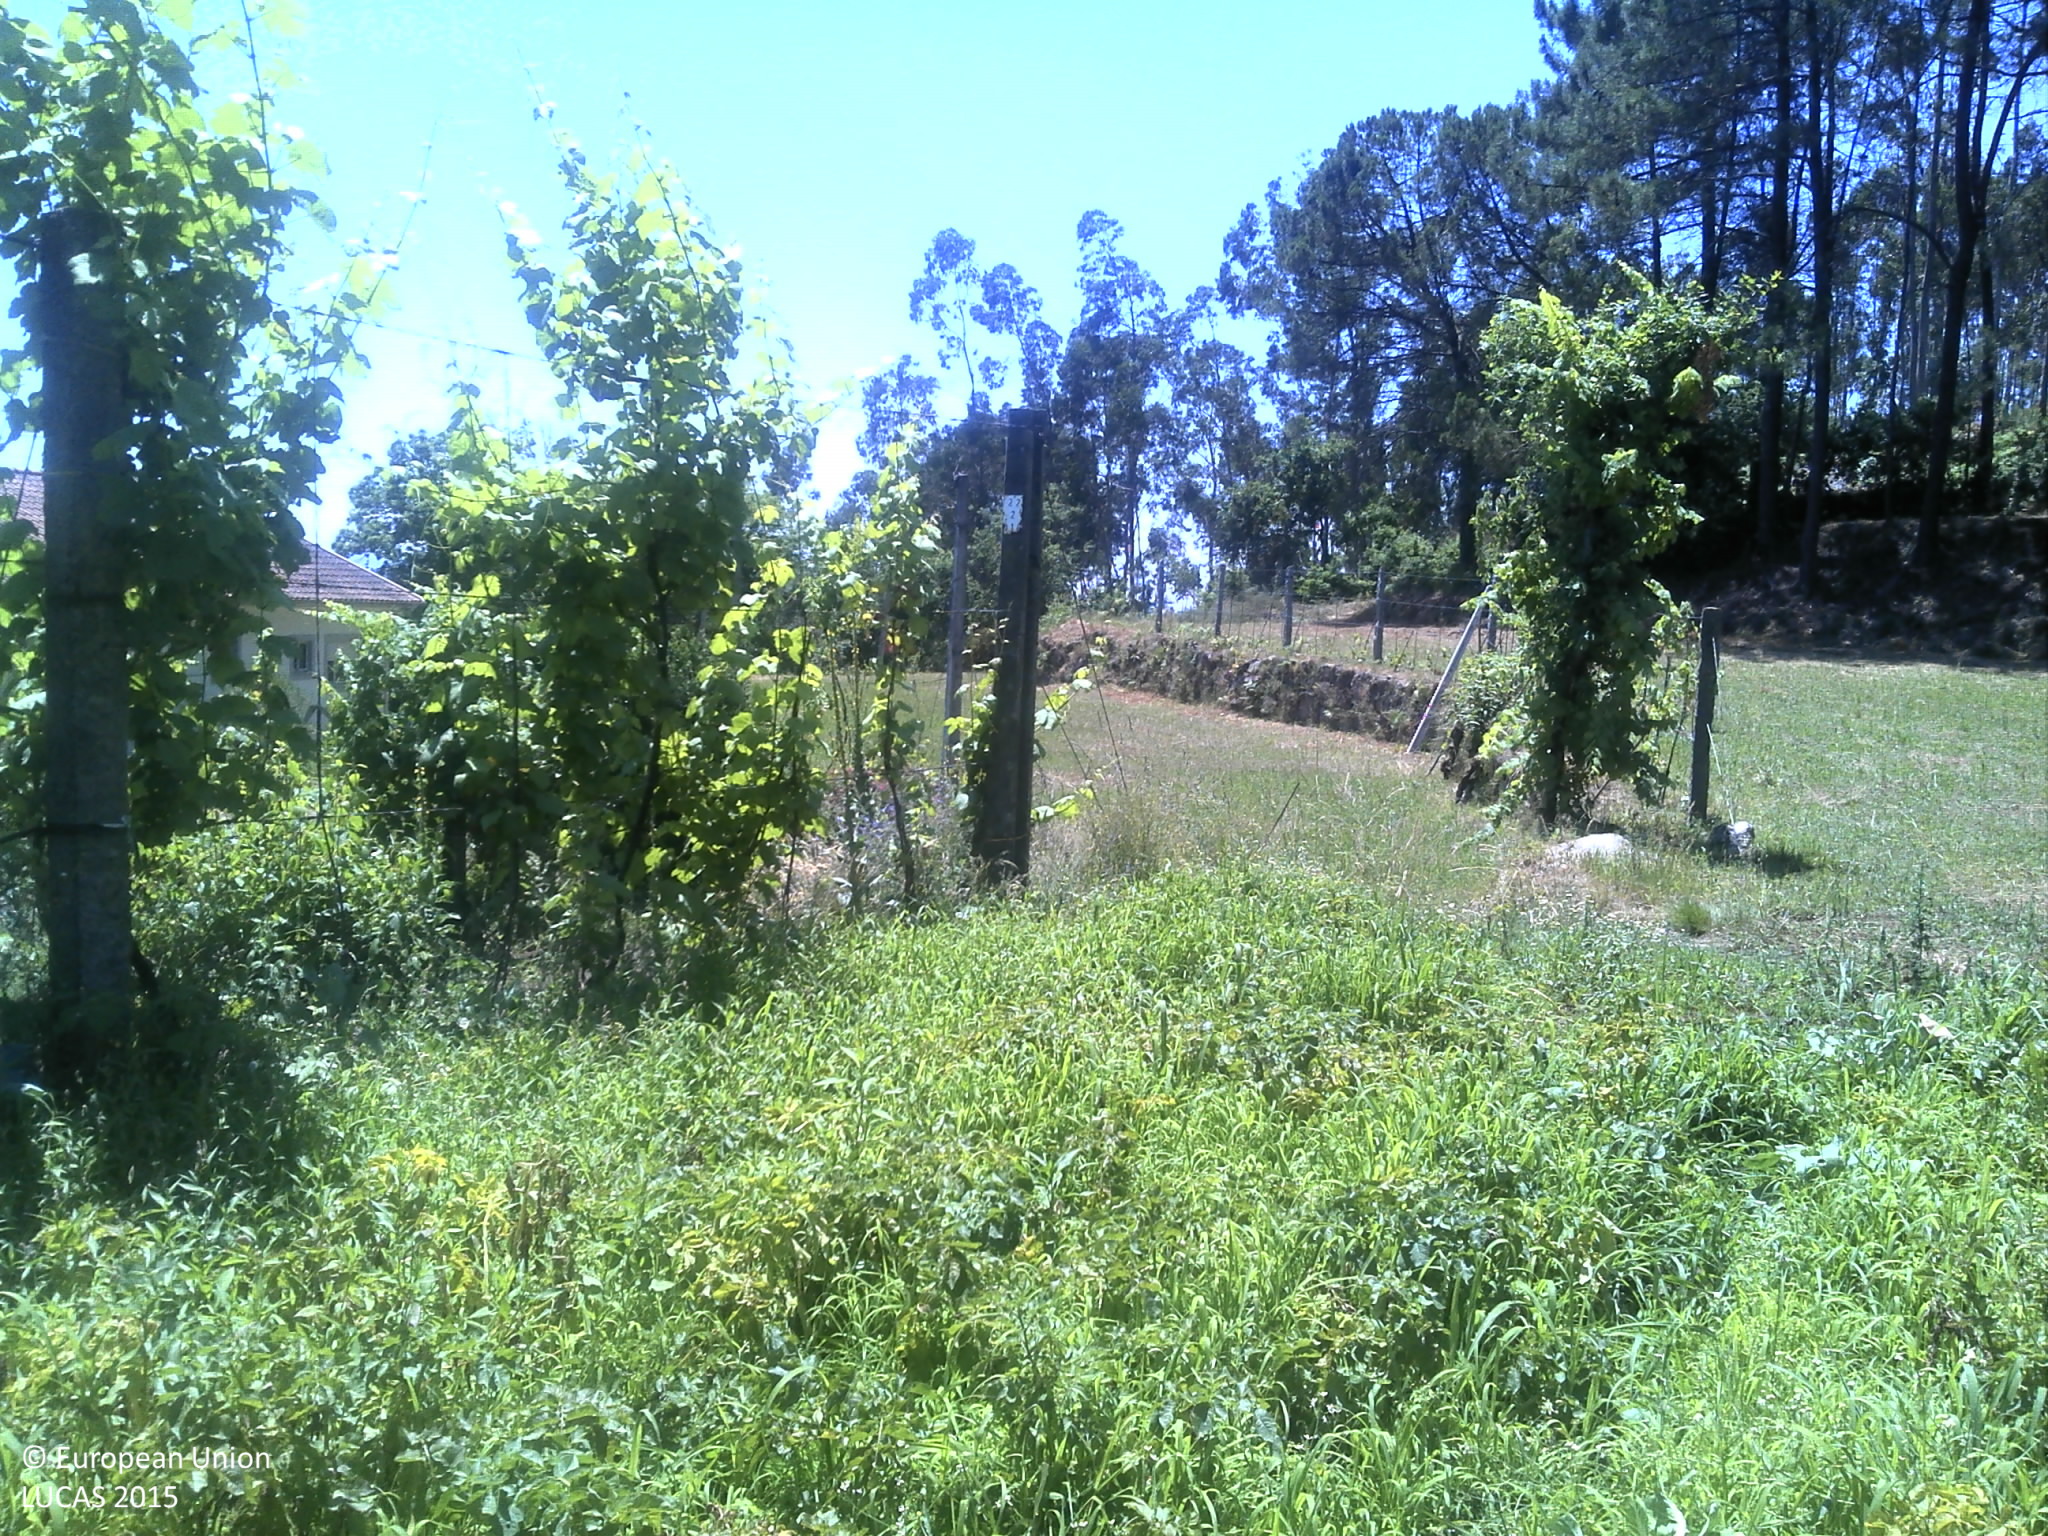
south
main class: Cropland
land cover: Other fresh vegetables
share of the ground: > 75 %
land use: Kitchen garden
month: June
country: PT
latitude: 41.5536
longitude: -8.3393
